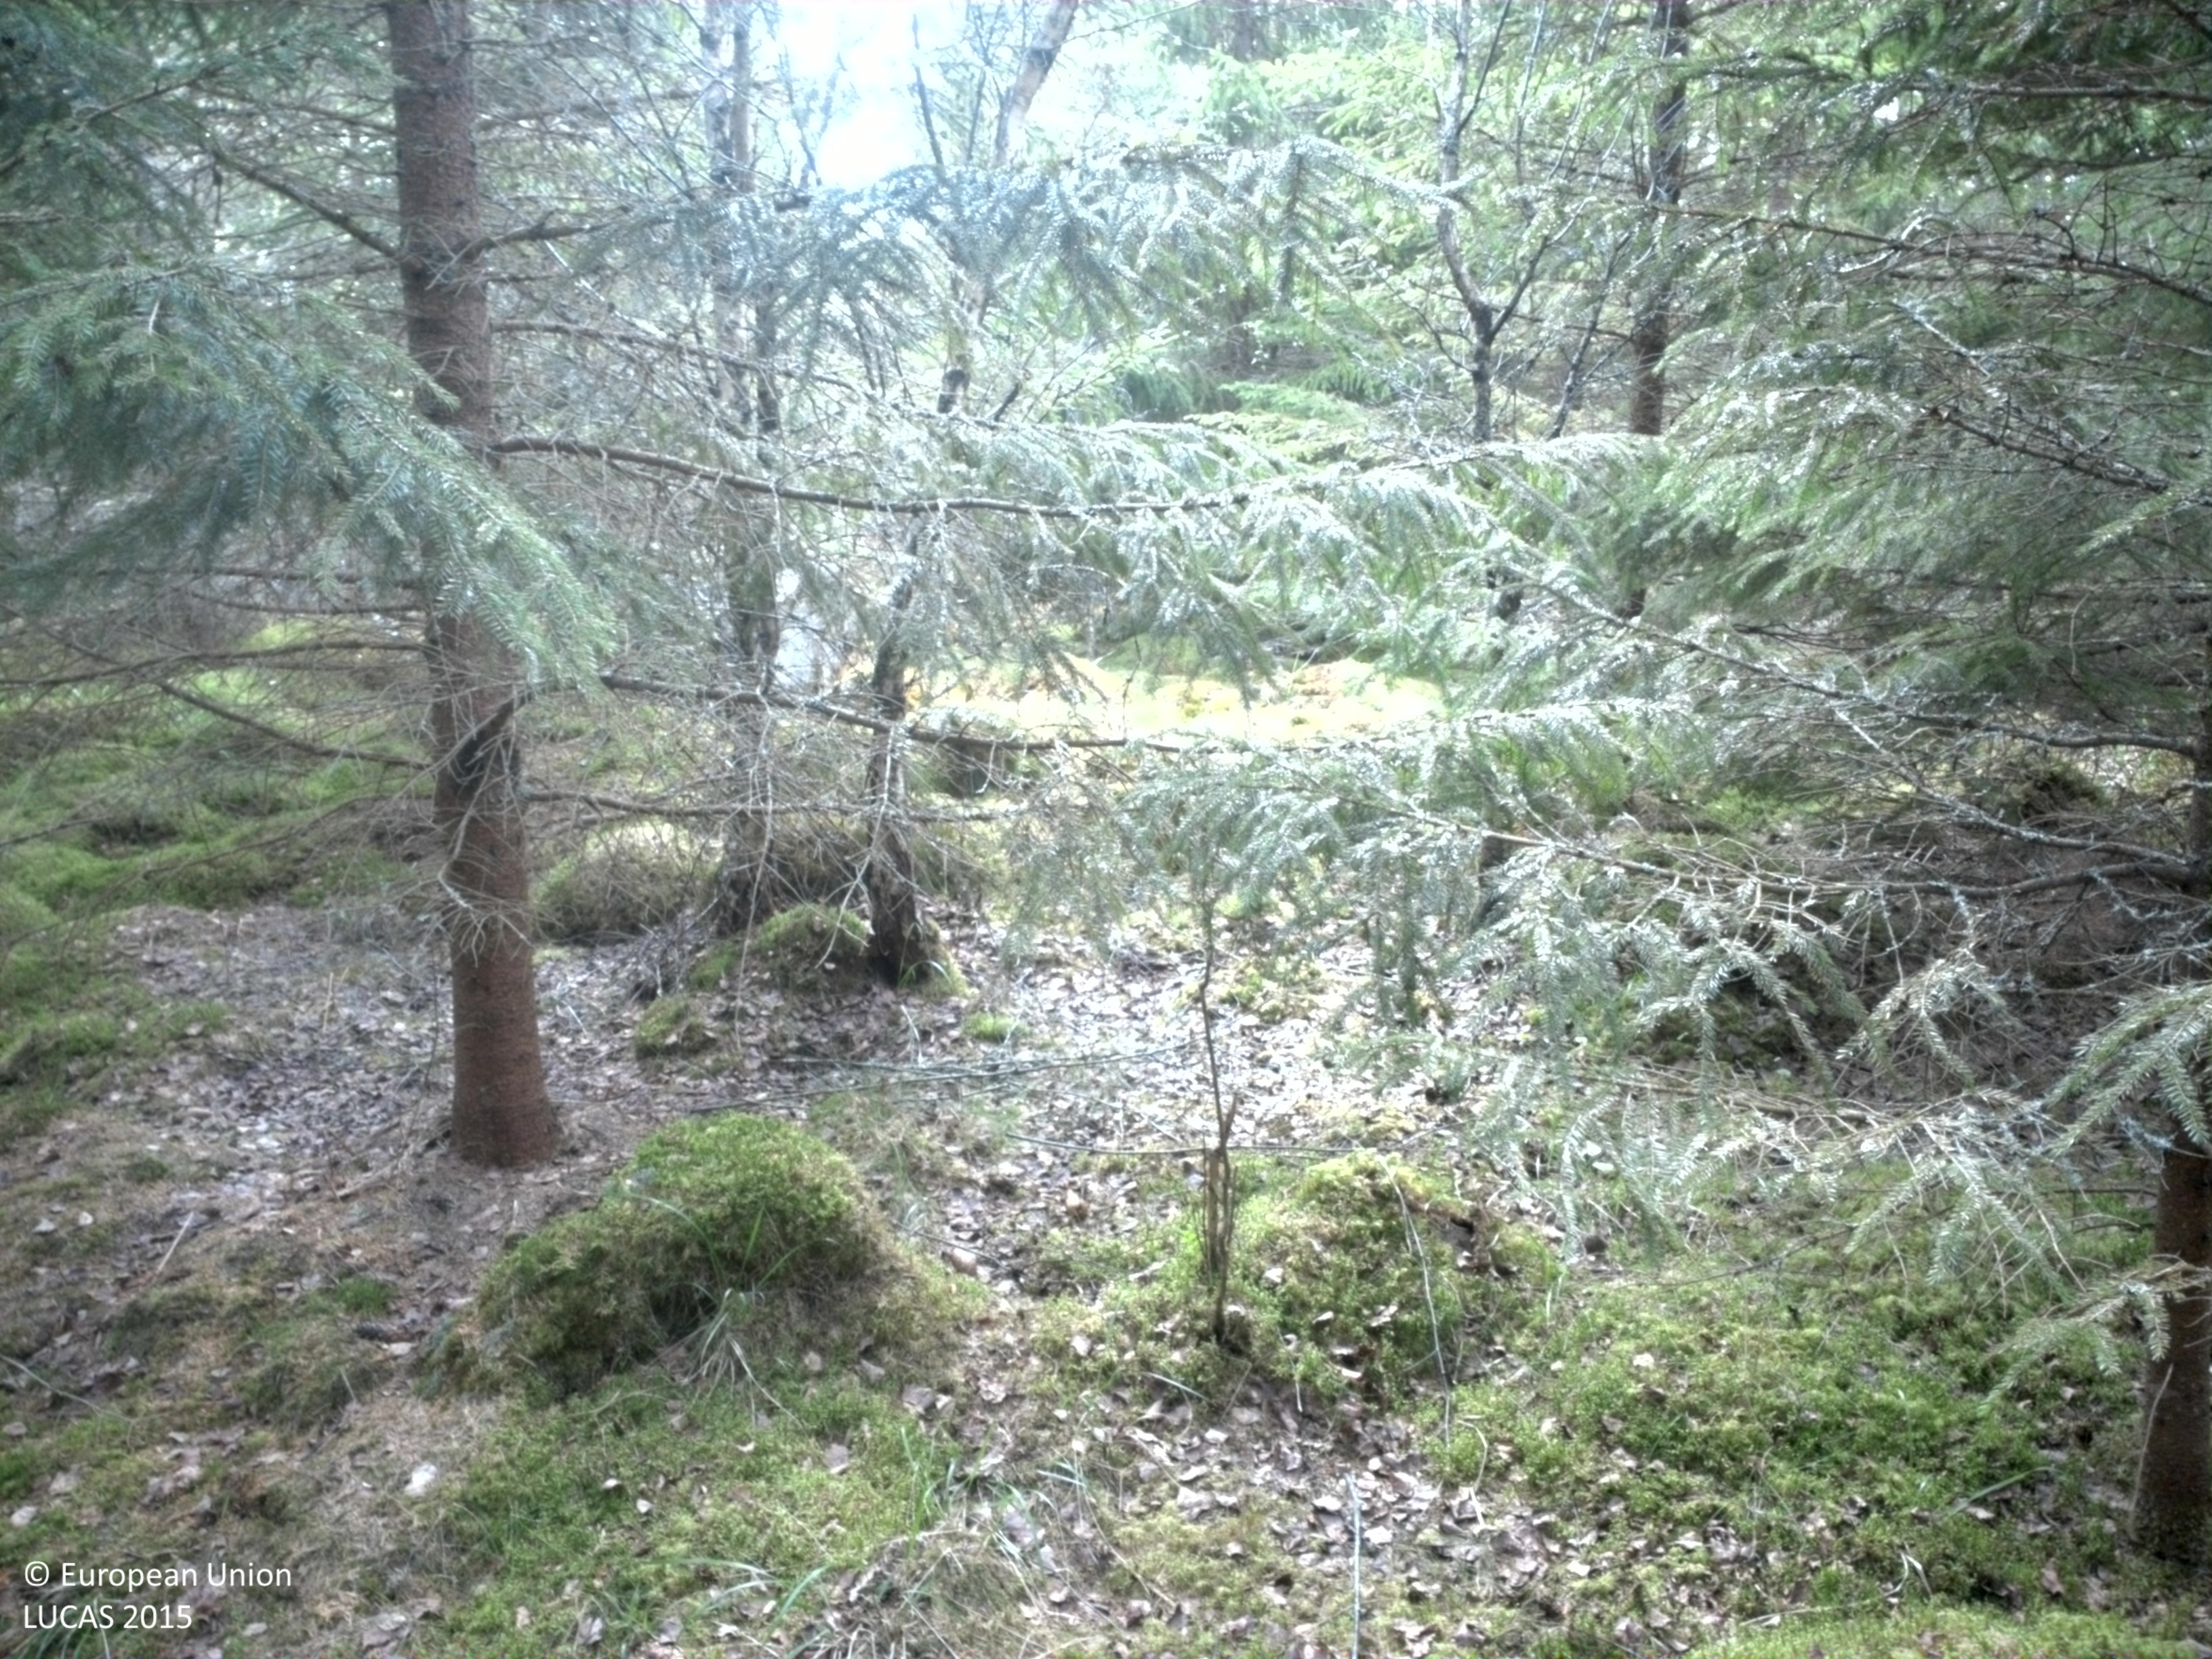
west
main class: Woodland
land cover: Spruce dominated coniferous woodland
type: boreal forest
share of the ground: > 75 %
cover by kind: coniferous forest trees 85 %, lichens and mosses 10 %, broadleaved forest trees 5 %
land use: Forestry
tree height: > 5 m
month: May
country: SE
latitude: 56.6961
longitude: 15.1745
